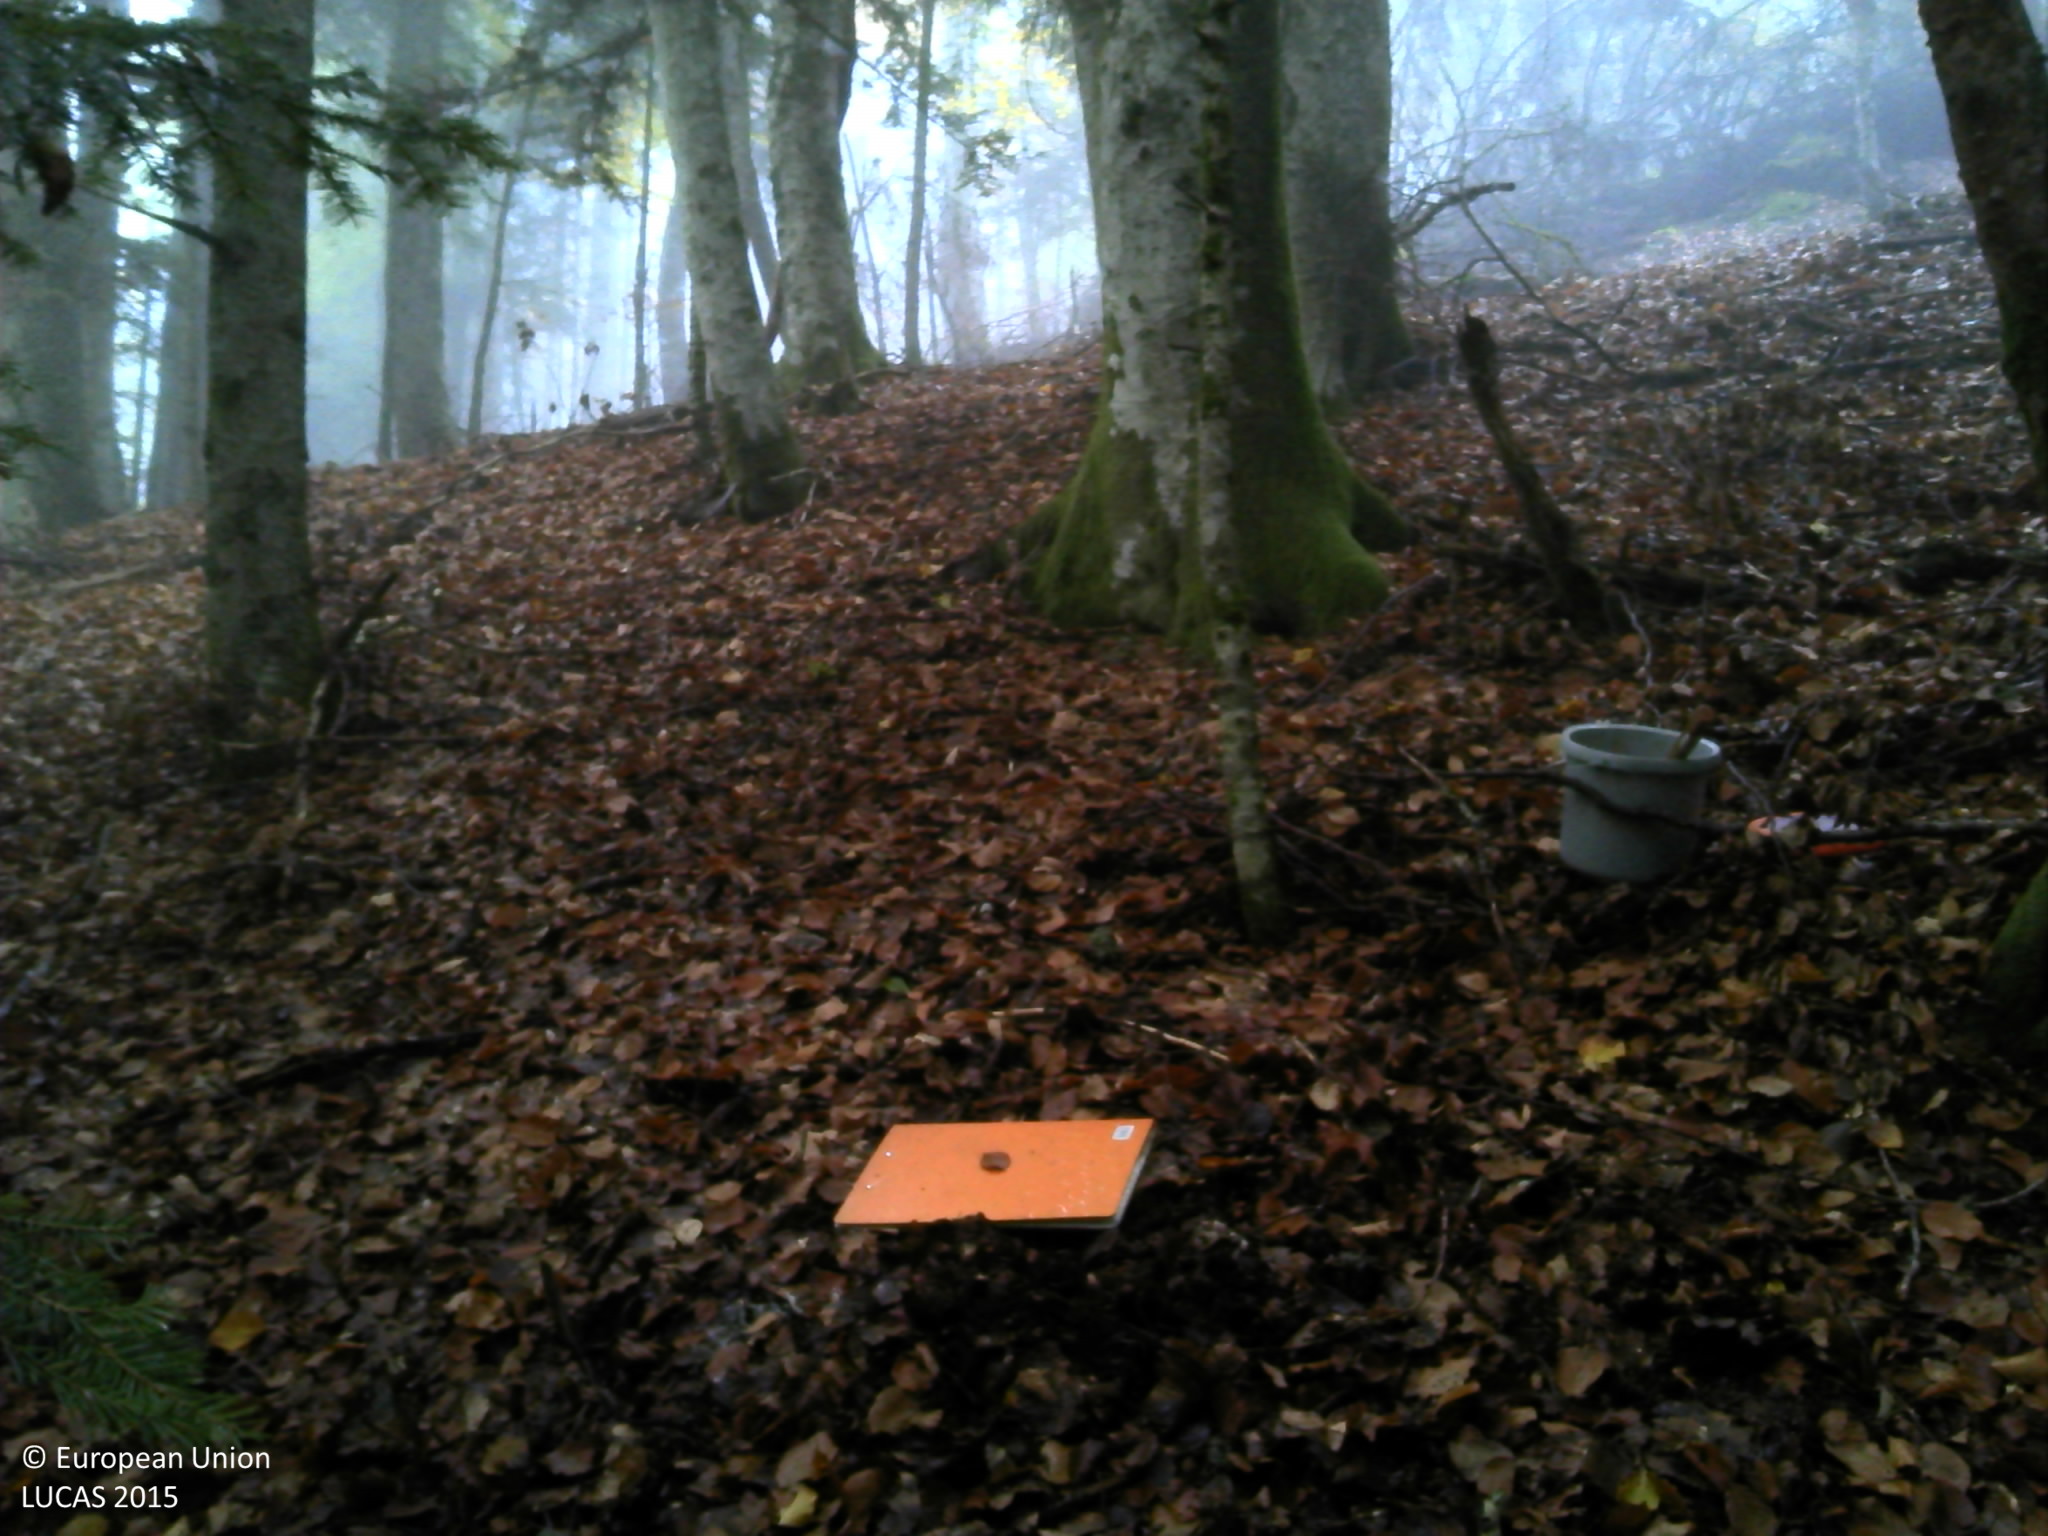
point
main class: Woodland
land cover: Spruce dominated mixed woodland
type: mountainous beech forest
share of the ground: > 75 %
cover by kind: broadleaved forest trees 50 %, coniferous forest trees 40 %, unconsolidated bare surface 10 %
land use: Forestry
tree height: > 5 m
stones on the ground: < 10 %
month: October
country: FR
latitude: 45.6447
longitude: 3.7535
